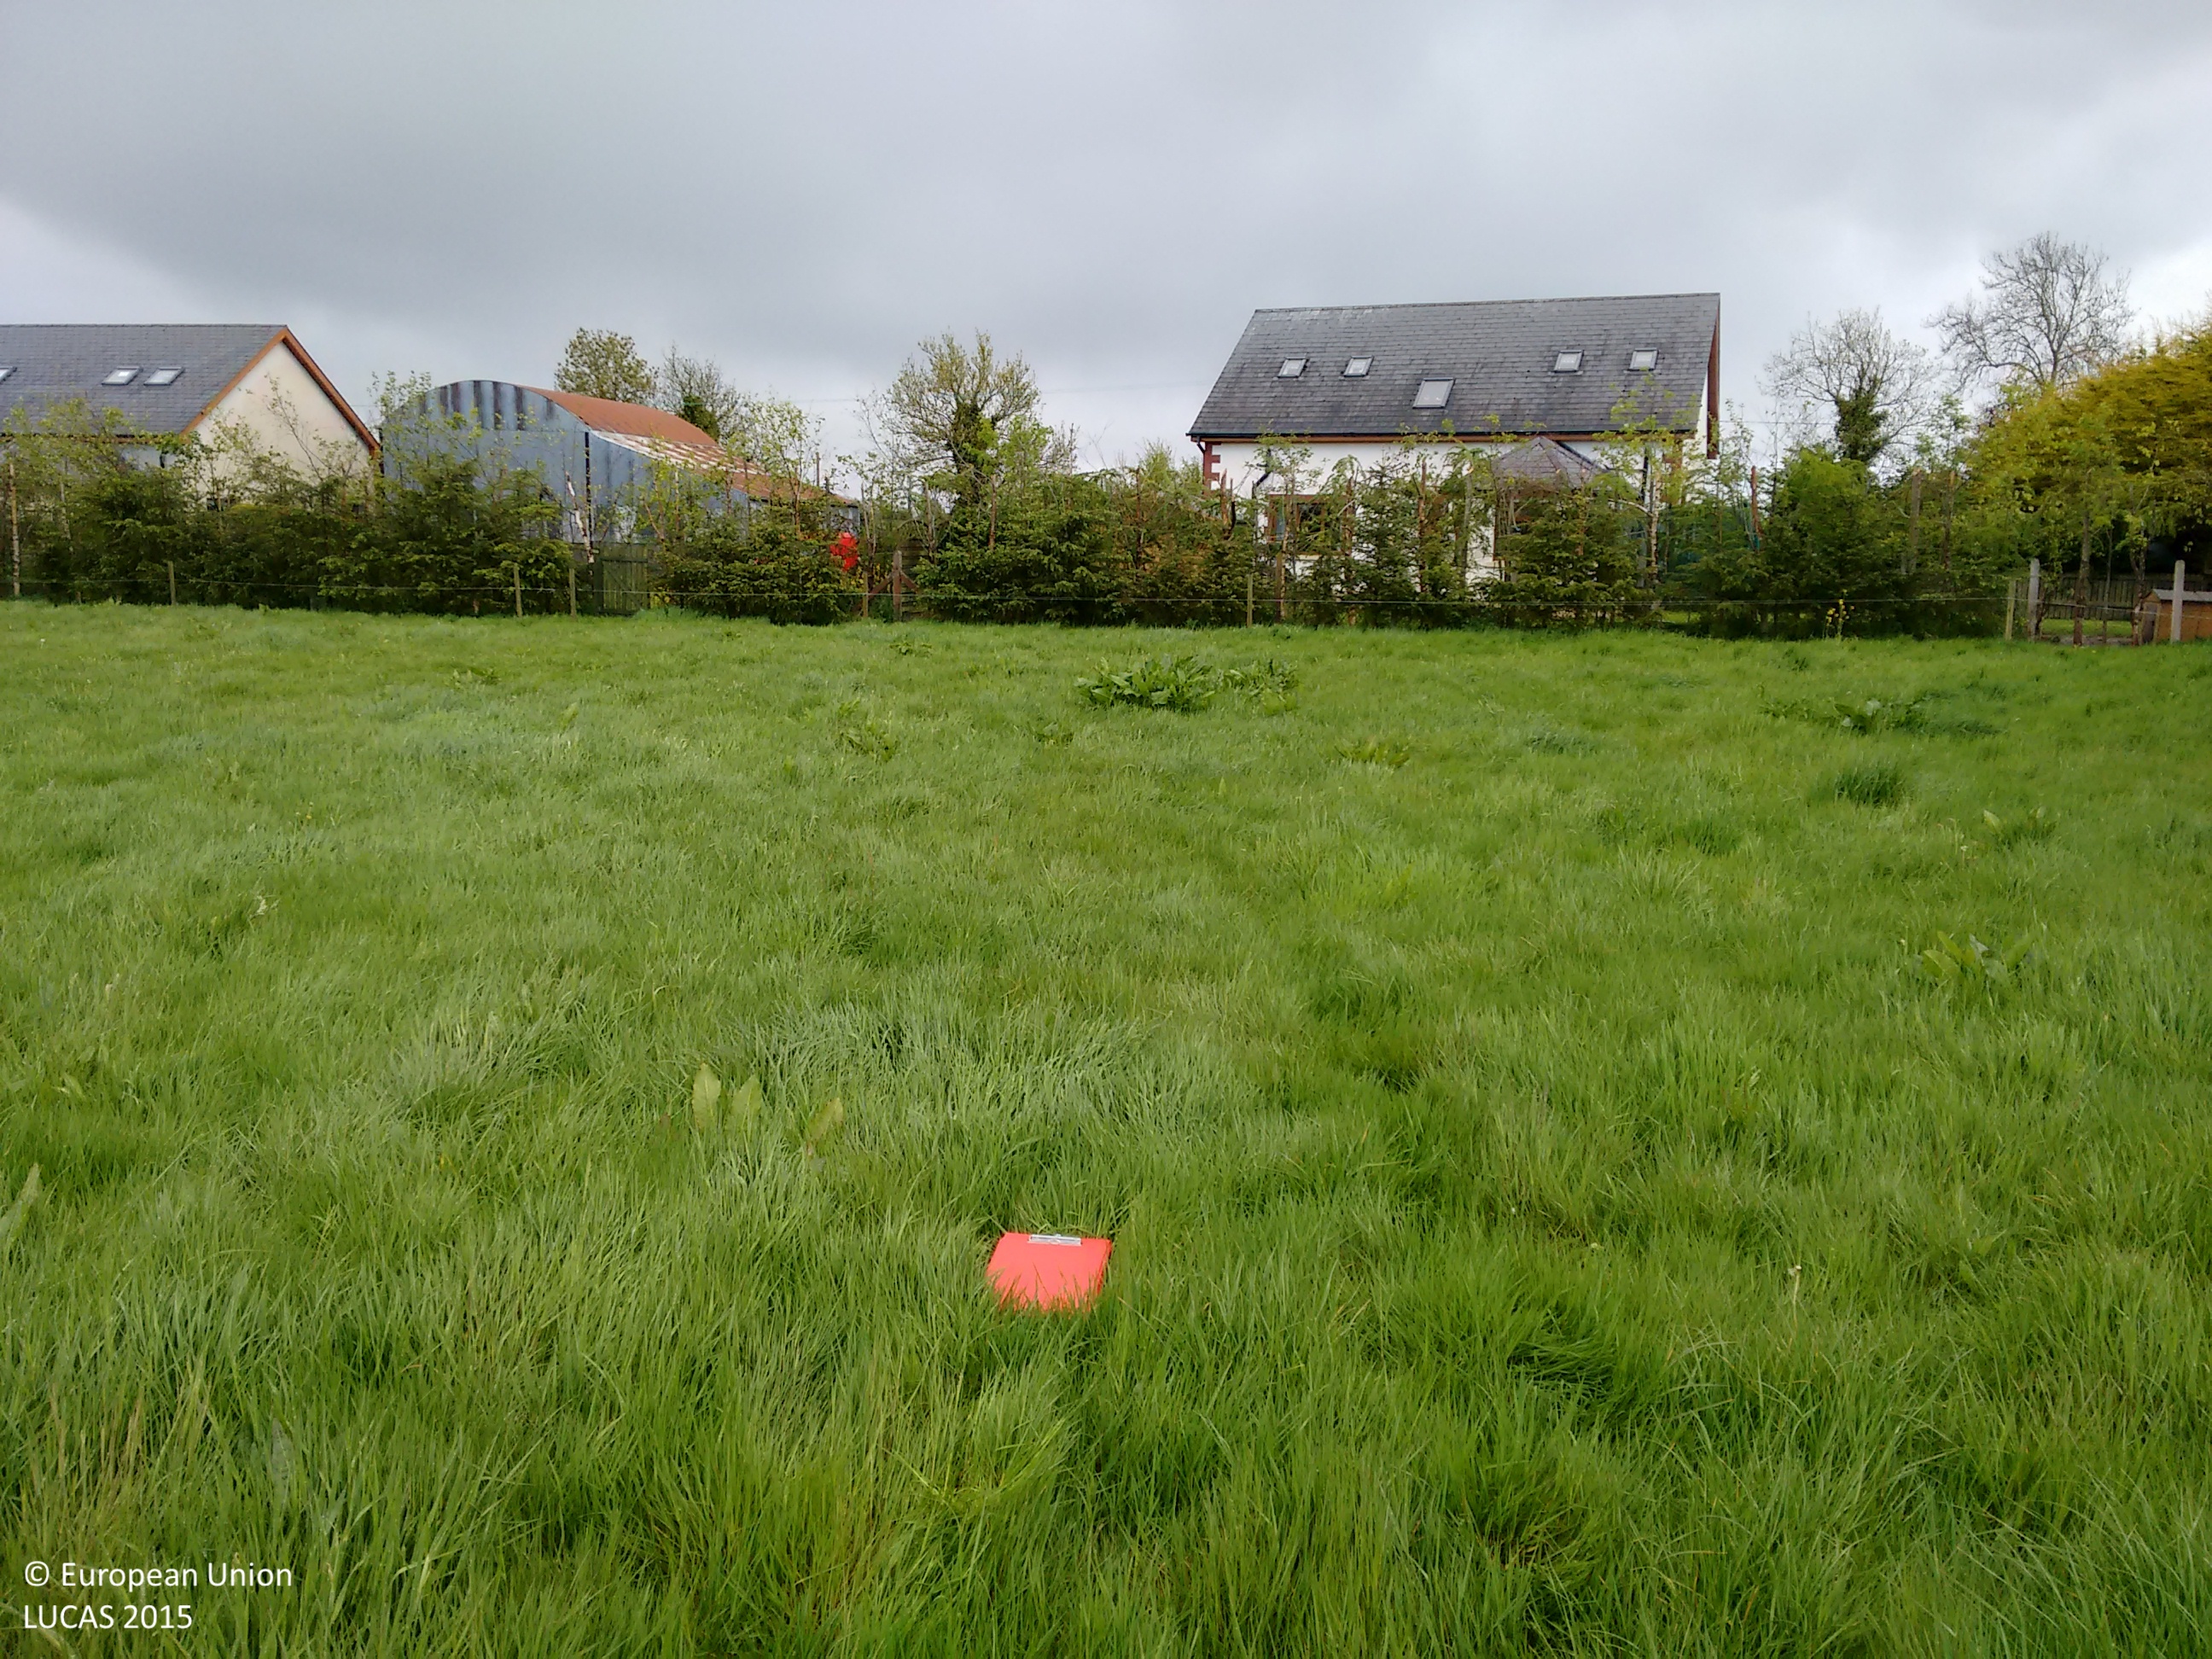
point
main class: Grassland
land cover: Grassland without tree/shrub cover
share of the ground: > 75 %
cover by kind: herbaceous plants 100 %
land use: Agriculture (excluding fallow land and kitchen gardens)
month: May
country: IE
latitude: 53.3944
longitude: -6.6584
